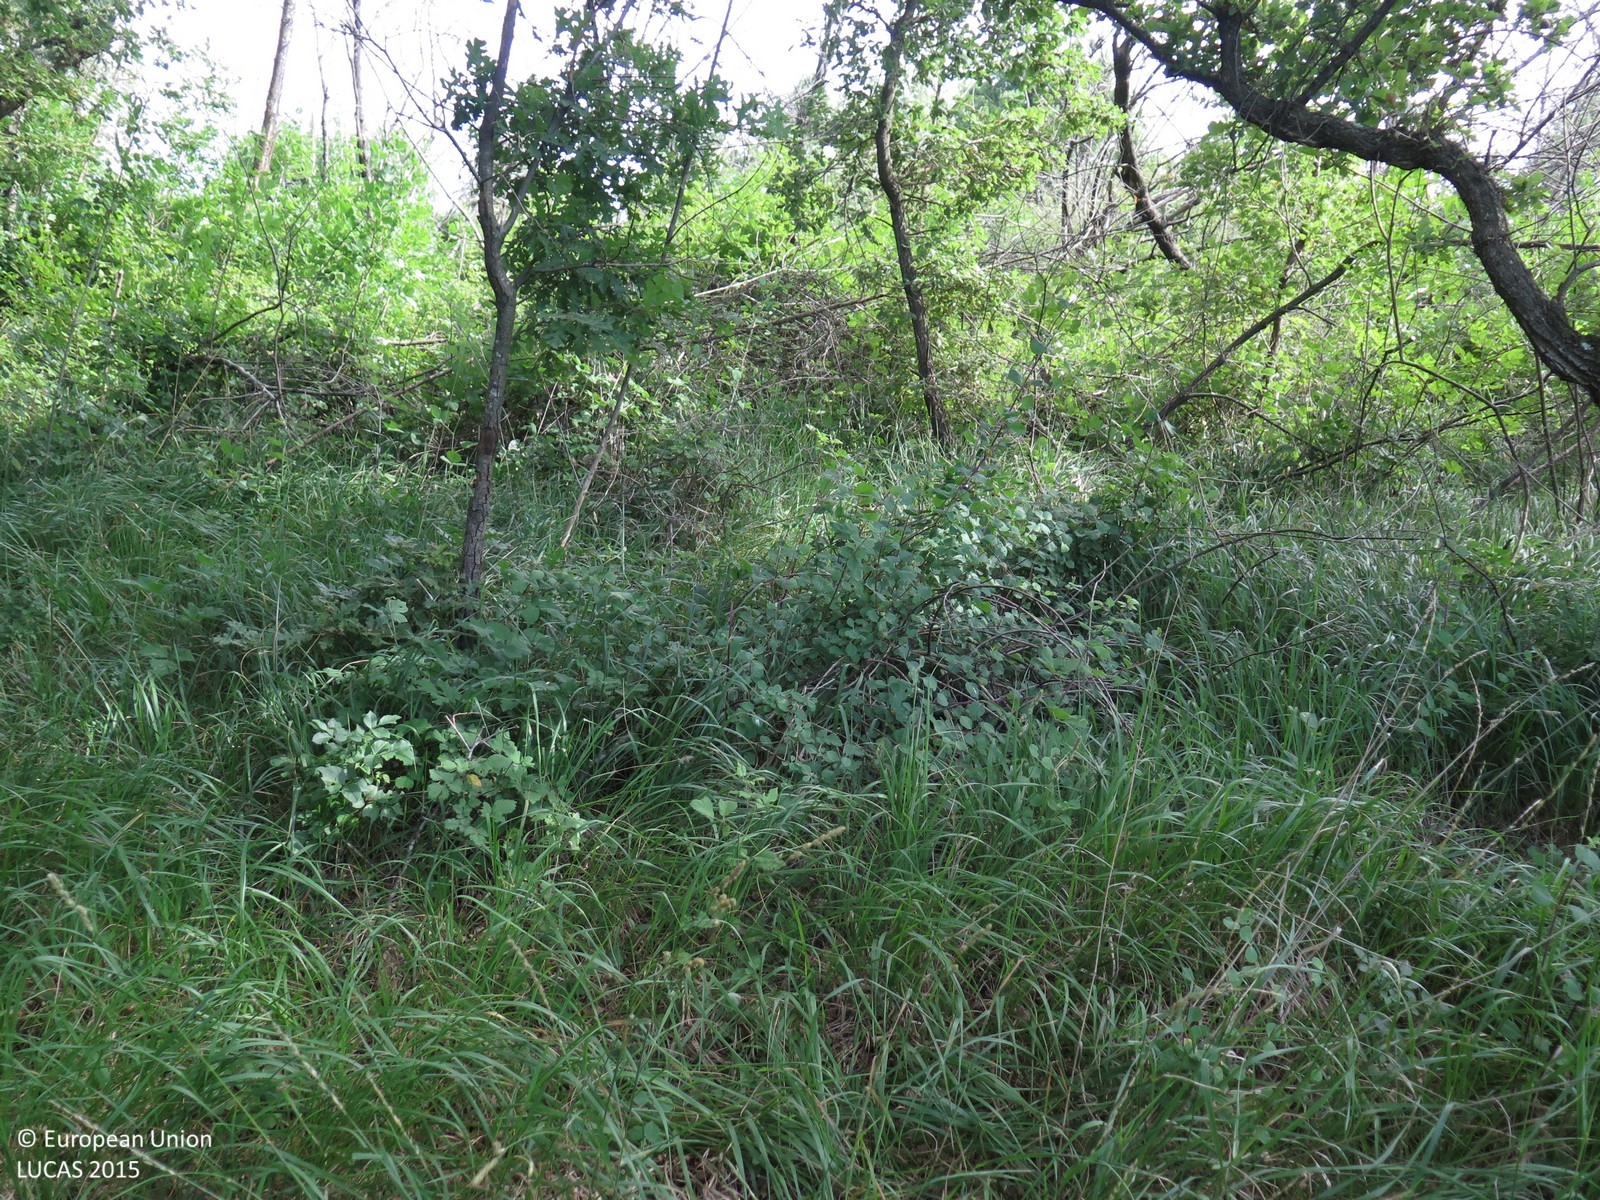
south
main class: Woodland
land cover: Broadleaved woodland
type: mesophytic deciduous forest
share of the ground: > 75 %
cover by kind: broadleaved forest trees 95 %, herbaceous plants 5 %
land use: Semi-natural and natural areas not in use
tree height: > 5 m
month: June
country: HR
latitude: 45.2024
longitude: 13.7758
